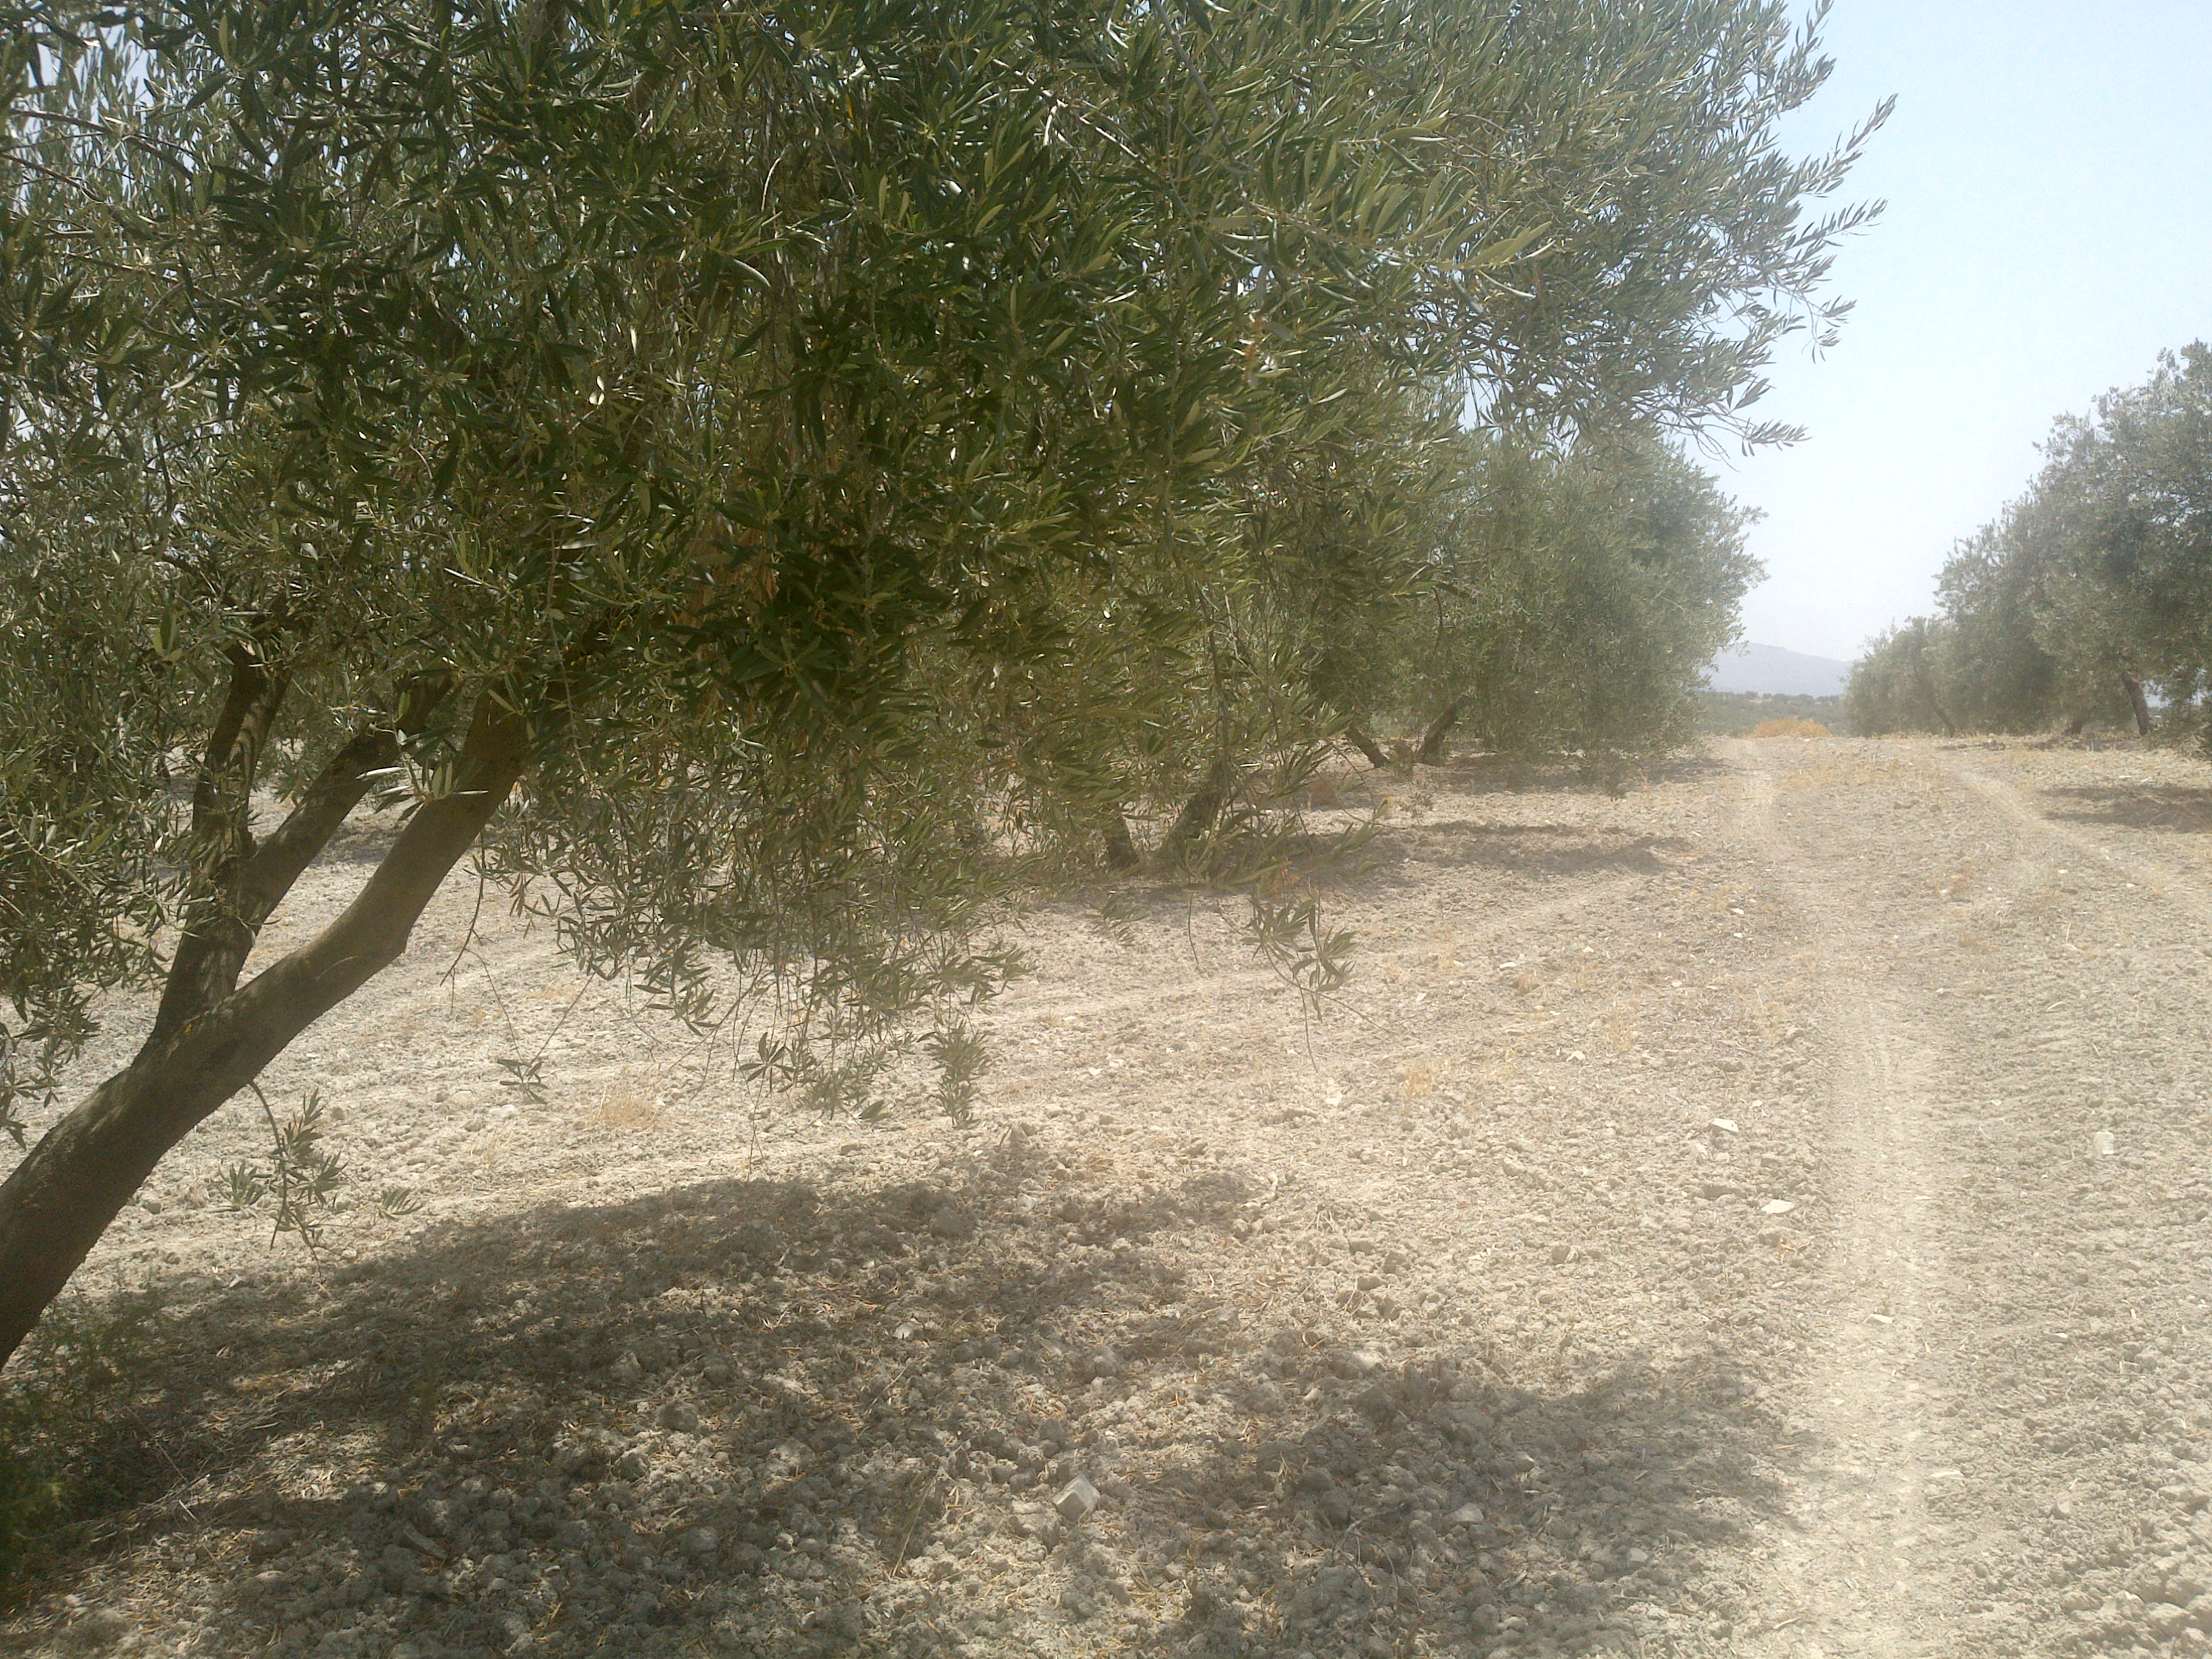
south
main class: Cropland
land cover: Olive groves
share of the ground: 50 - 75 %
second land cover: Other bare soil
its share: > 75 %
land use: Agriculture (excluding fallow land and kitchen gardens)
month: June
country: ES
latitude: 37.6103
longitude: -4.2197
